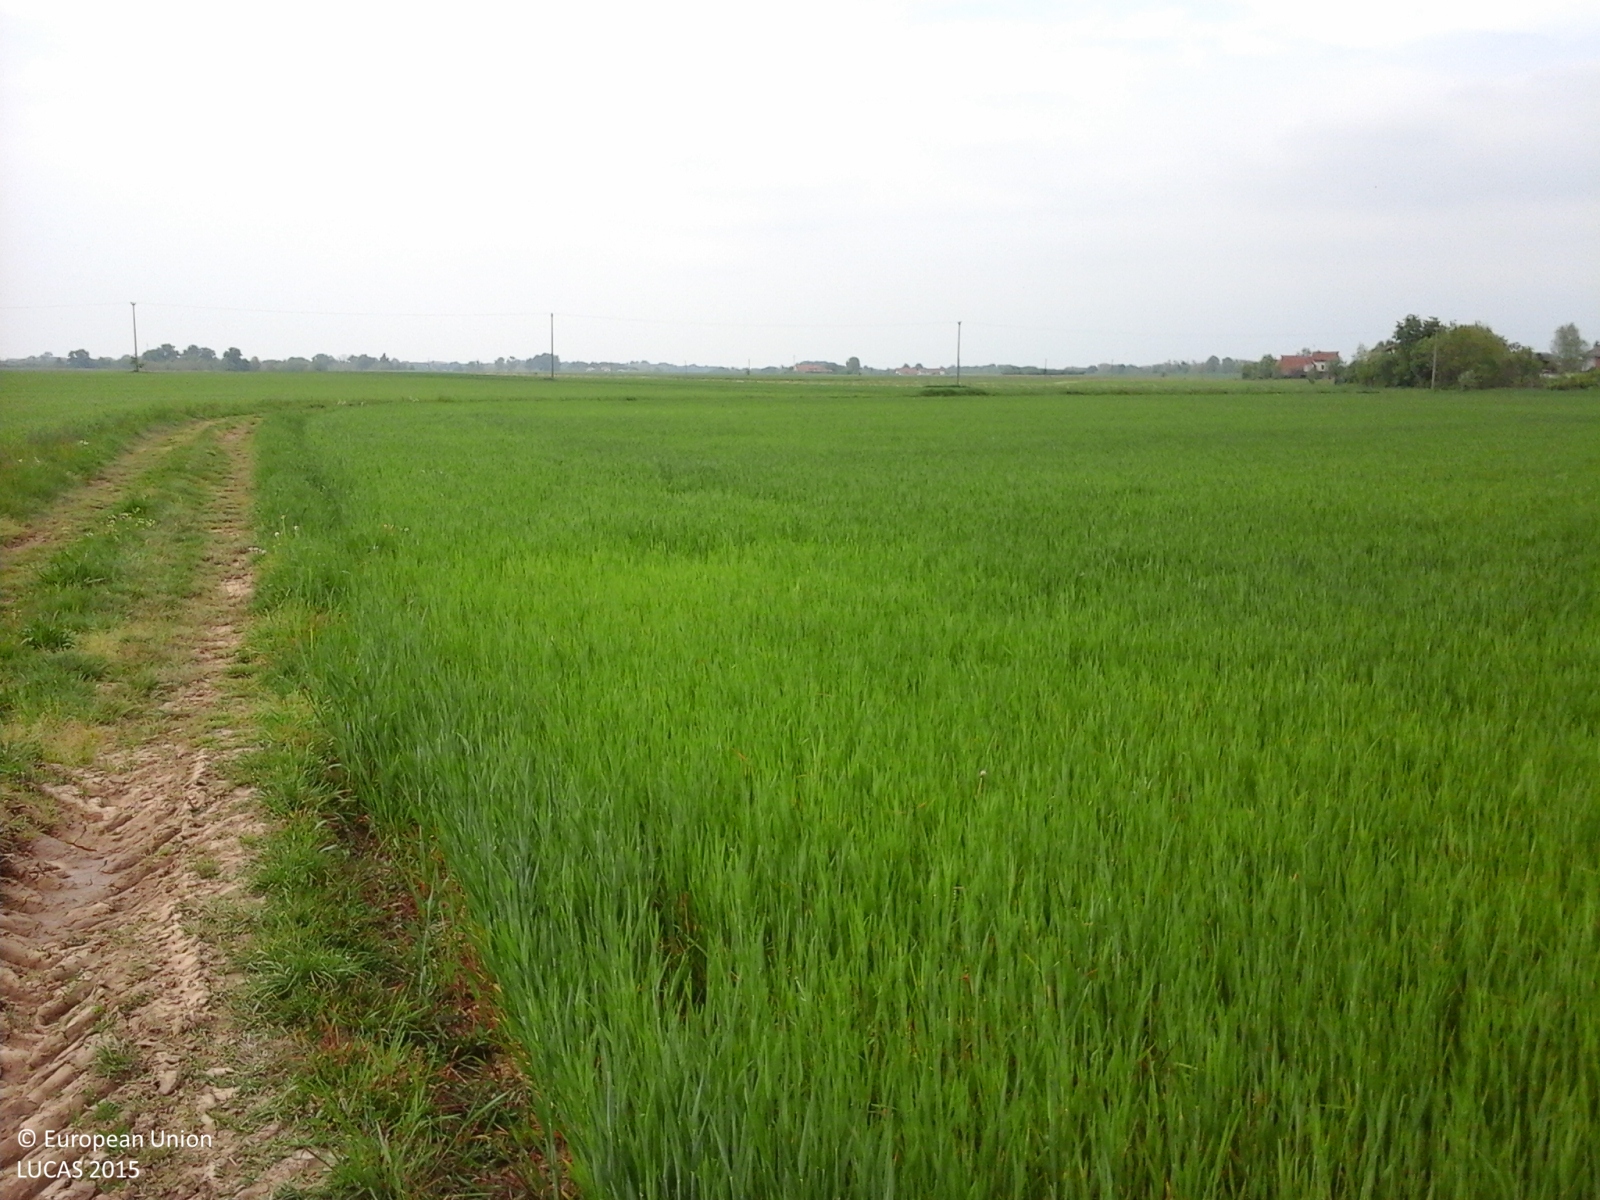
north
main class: Cropland
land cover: Common wheat
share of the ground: > 75 %
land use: Agriculture (excluding fallow land and kitchen gardens)
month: May
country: IT
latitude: 44.5623
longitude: 7.8263
